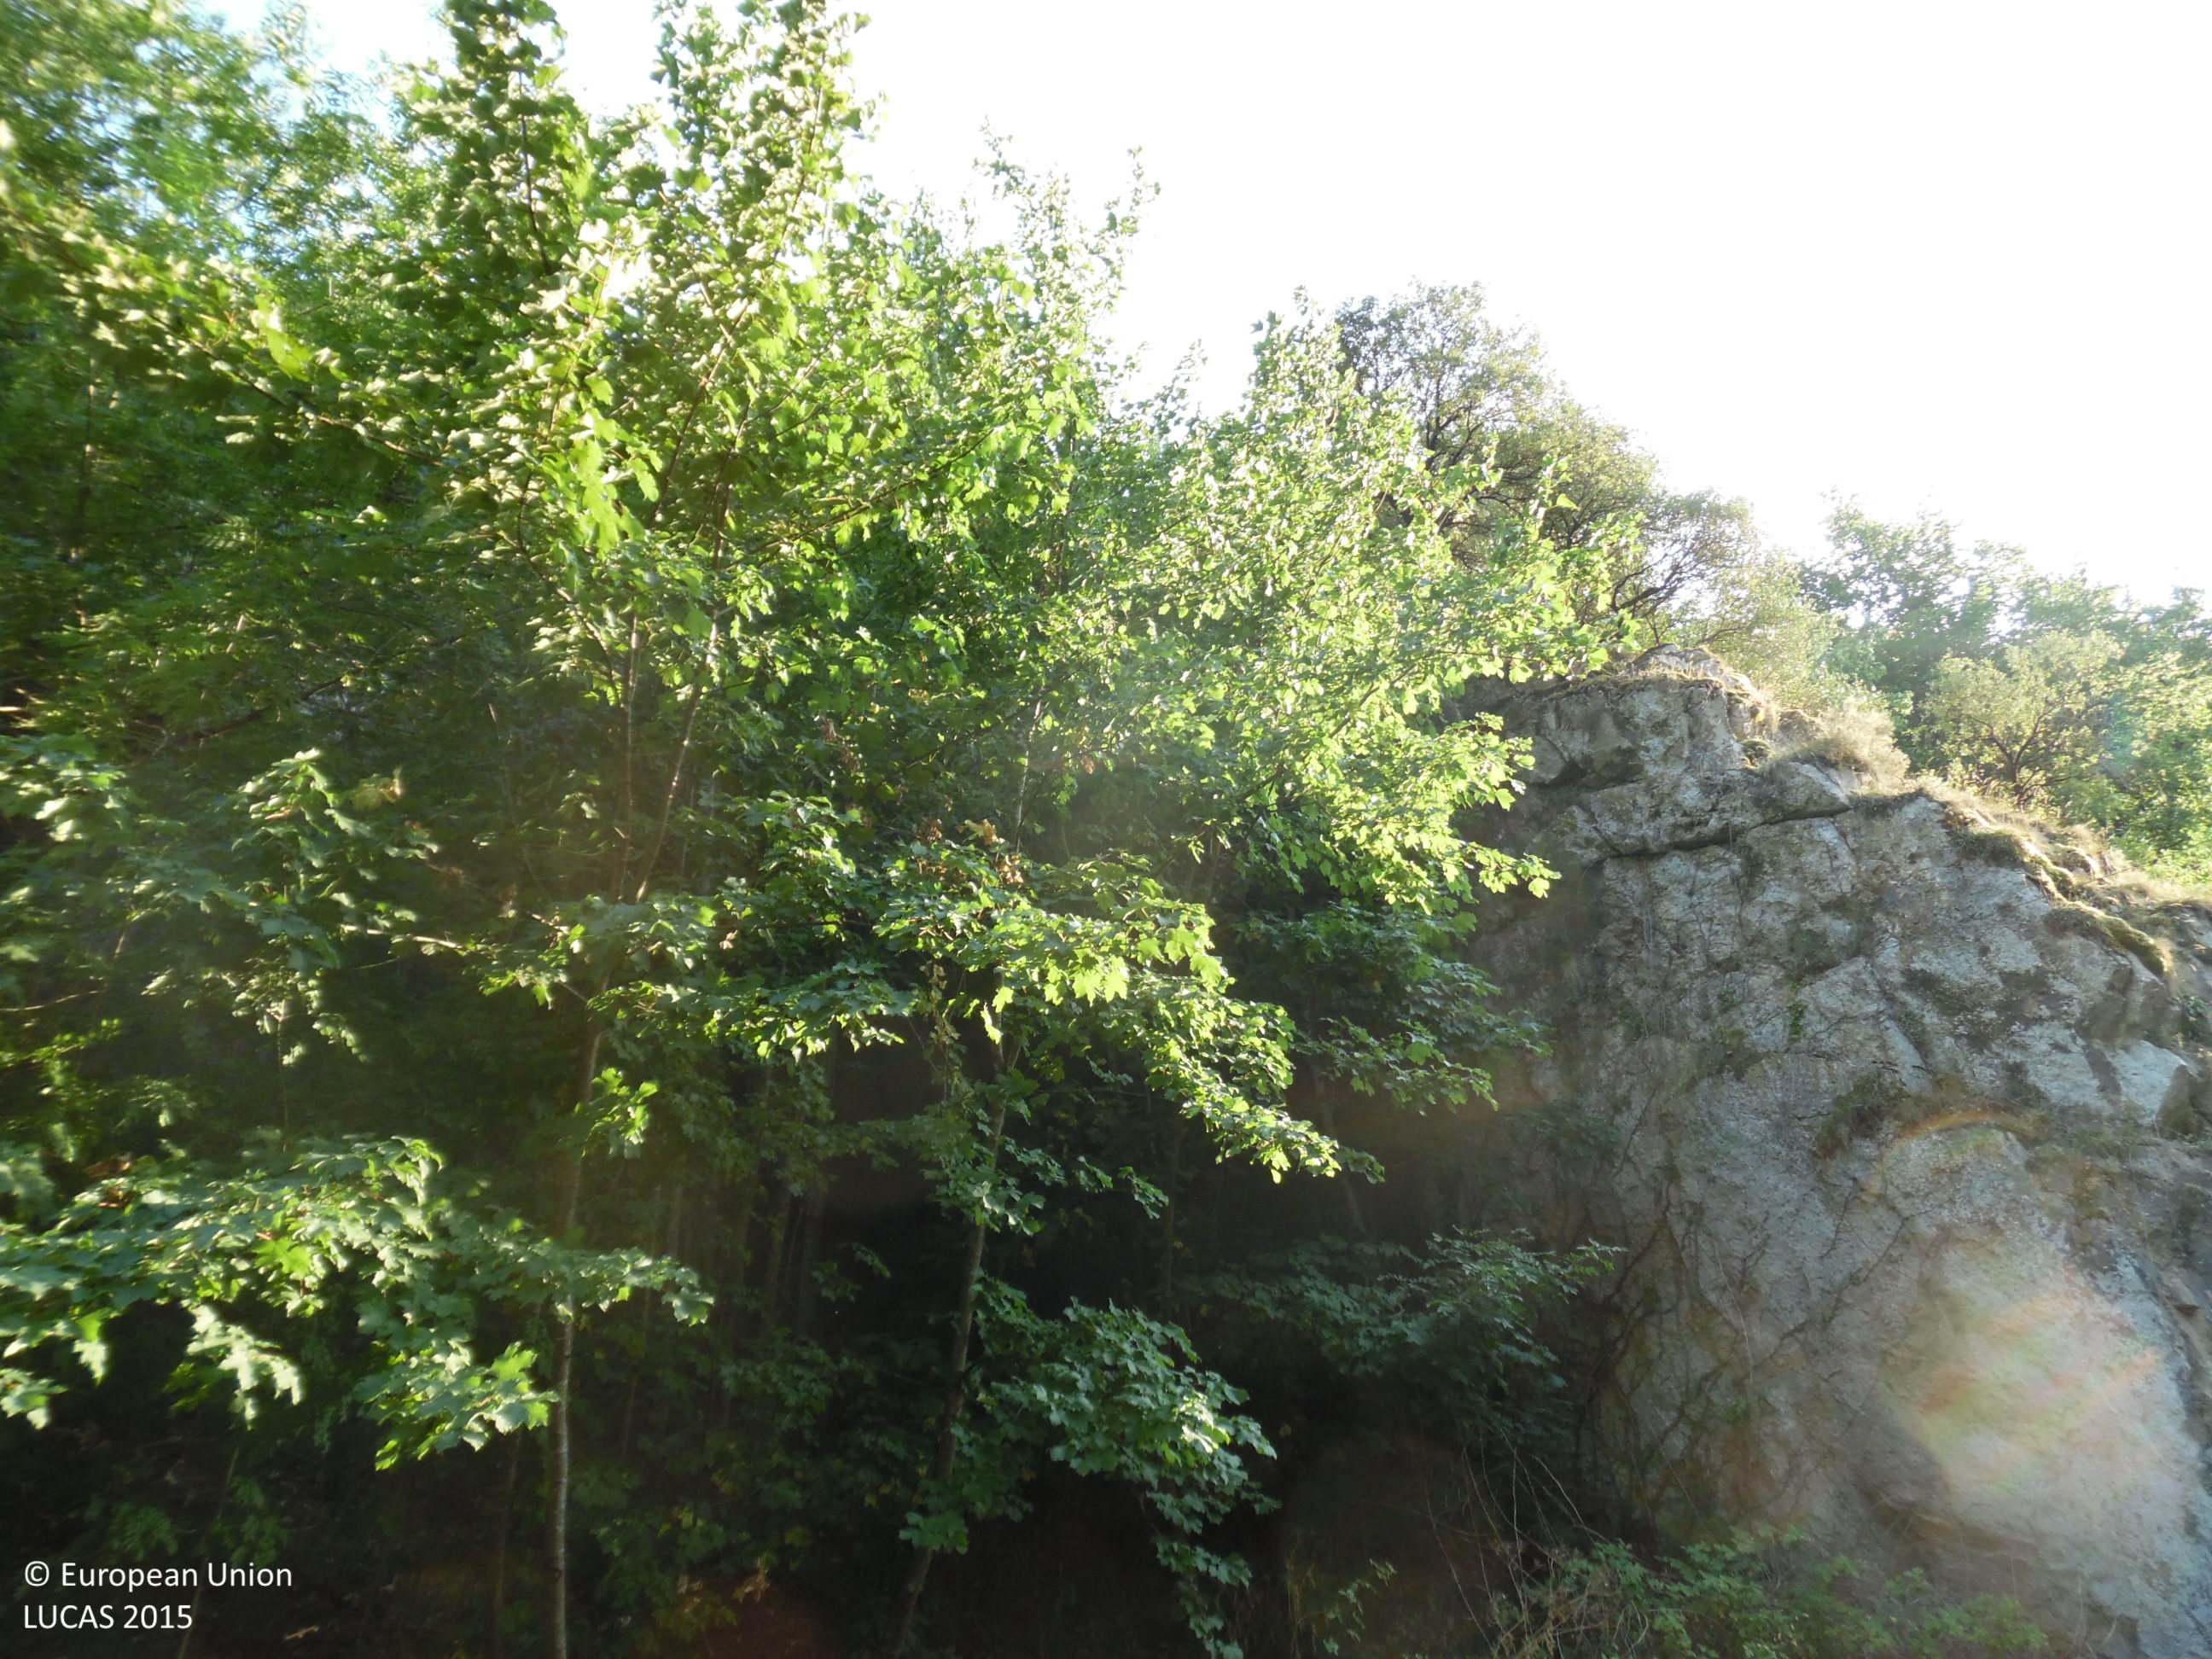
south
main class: Woodland
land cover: Broadleaved woodland
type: thermophilous deciduous forest
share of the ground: > 75 %
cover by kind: broadleaved forest trees 95 %, shrubs 5 %
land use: Forestry
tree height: > 5 m
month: July
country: ES
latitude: 43.1664
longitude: -6.2696
